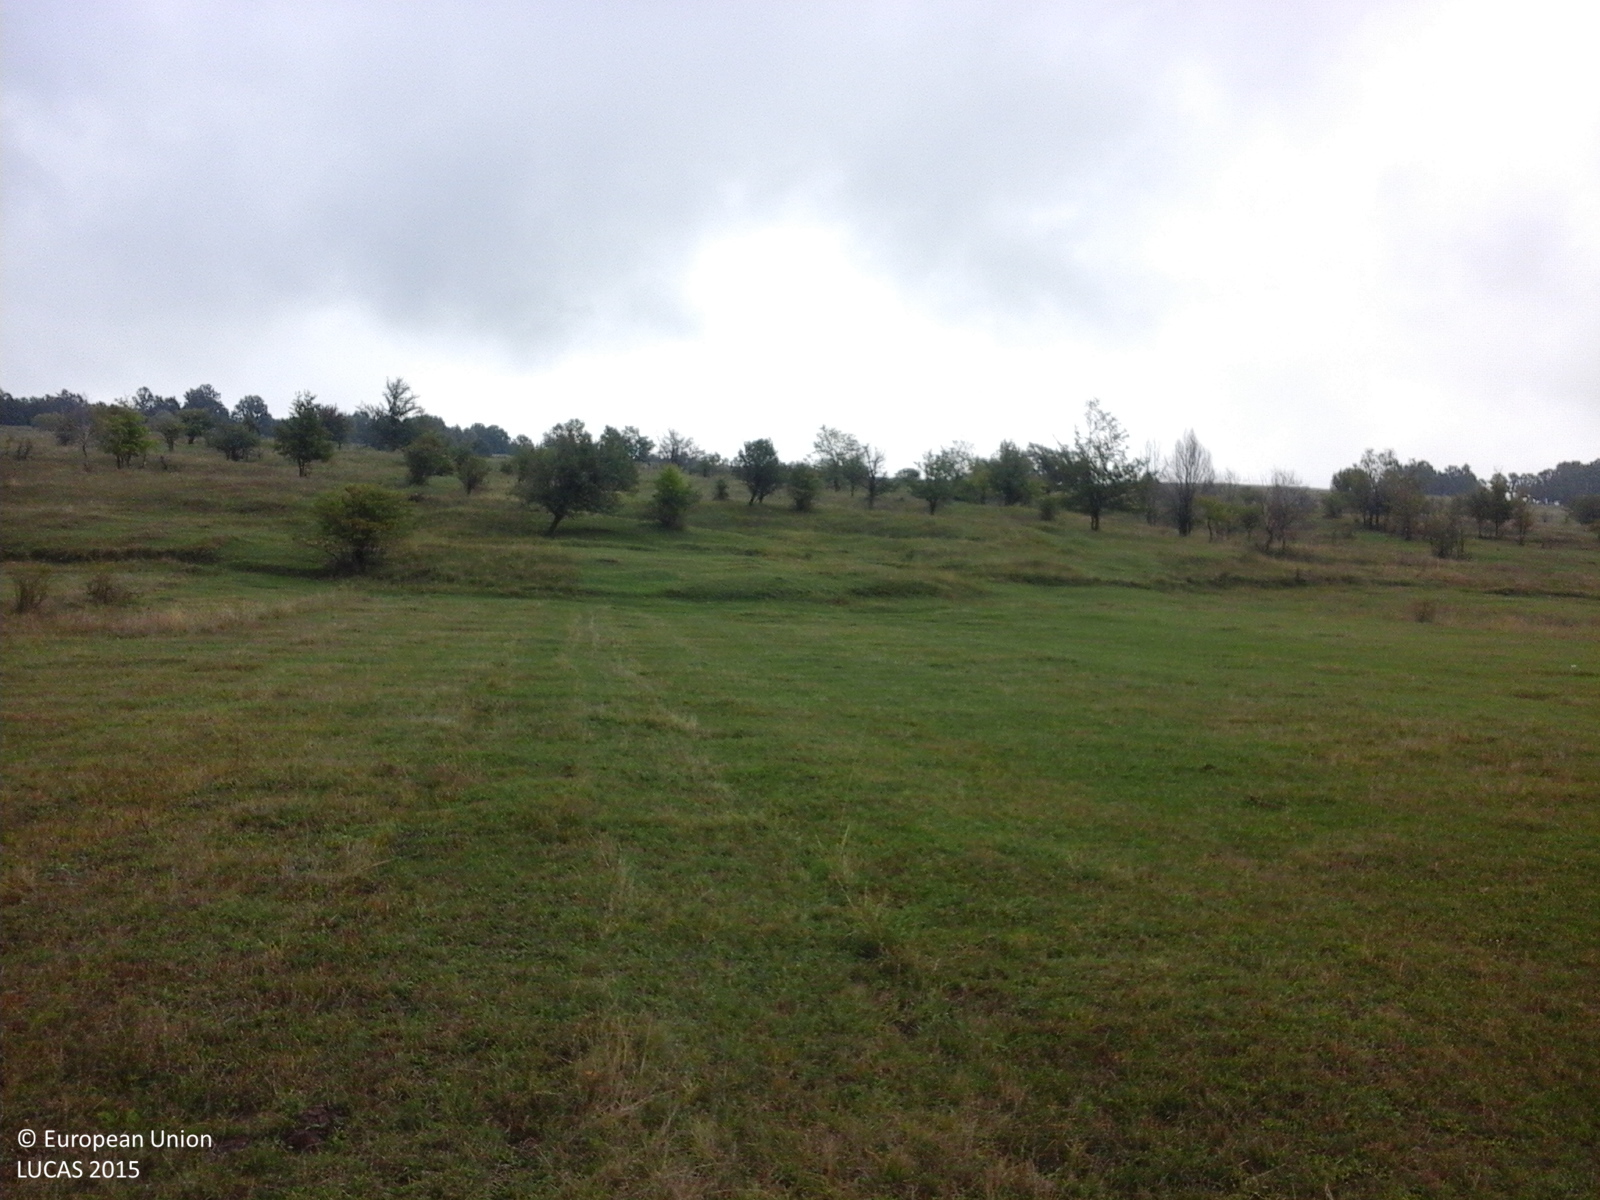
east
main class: Grassland
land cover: Grassland without tree/shrub cover
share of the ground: > 75 %
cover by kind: herbaceous plants 100 %
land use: Agriculture (excluding fallow land and kitchen gardens)
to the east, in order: Grassland without tree/shrub cover; Tracks; Grassland with sparse tree/shrub cover
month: September
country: RO
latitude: 45.1146
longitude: 23.1579
